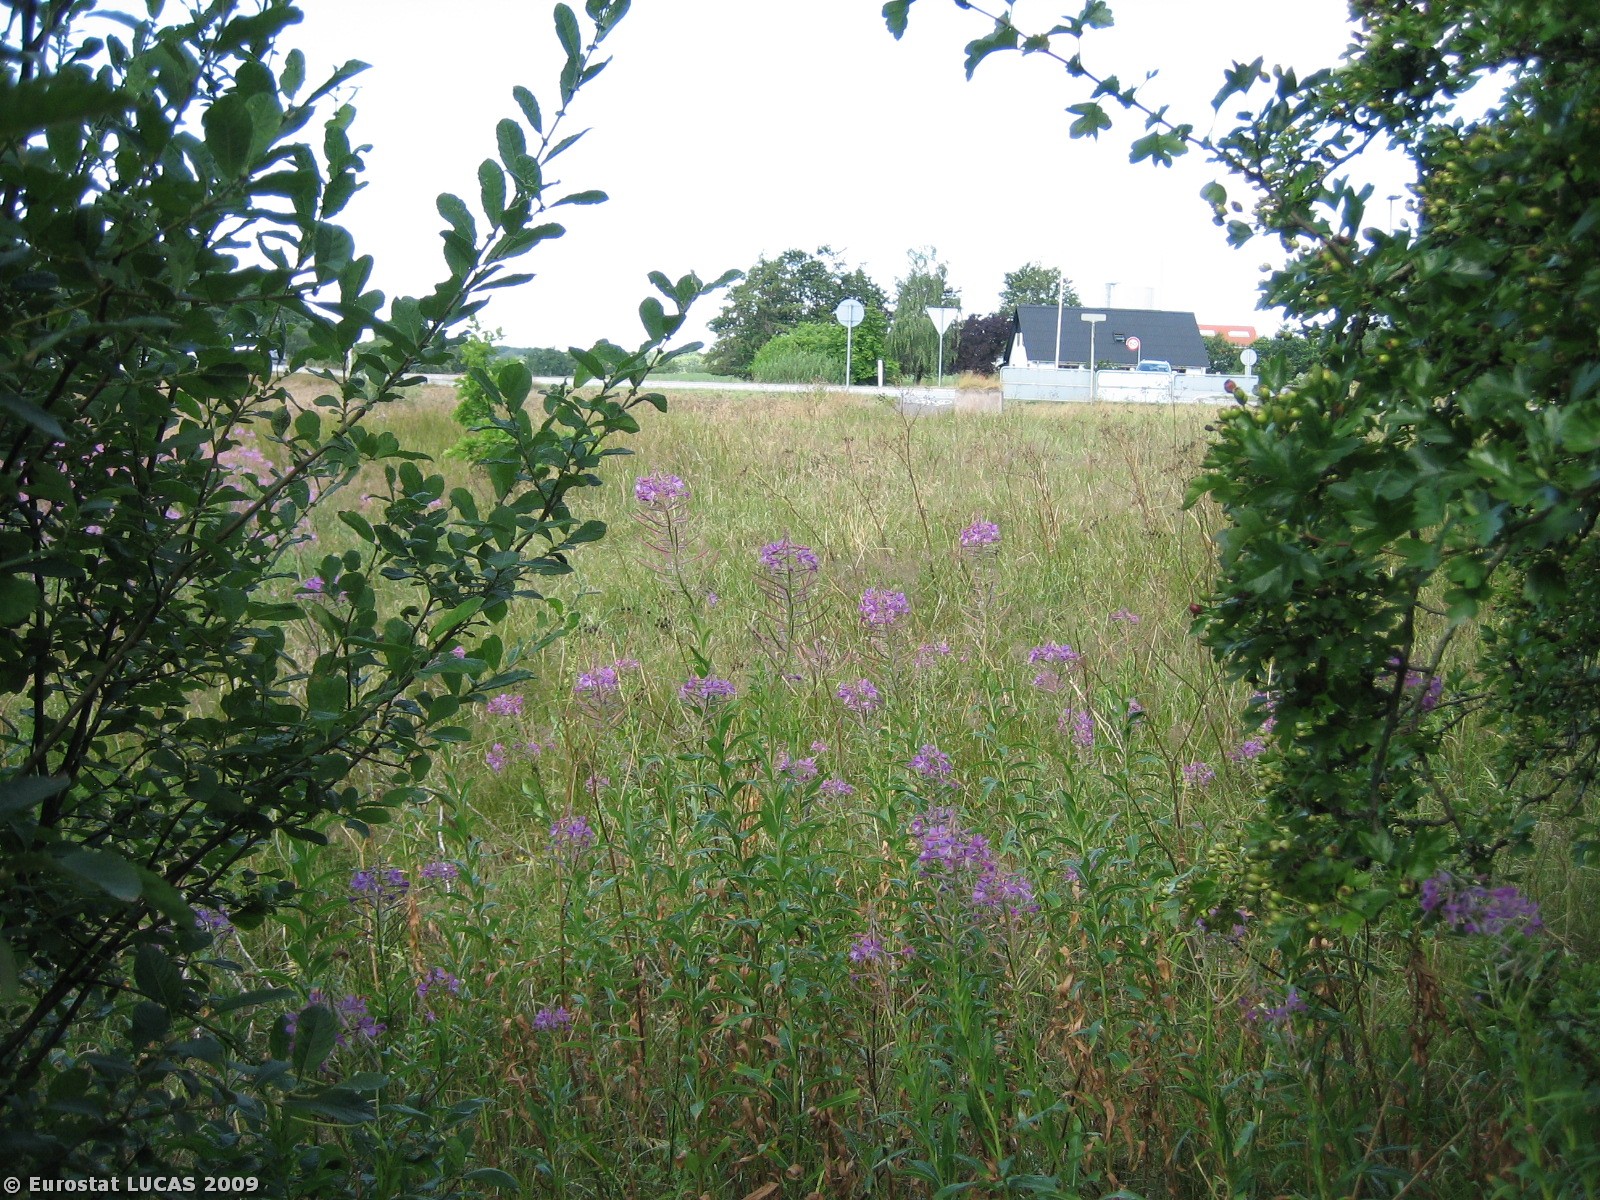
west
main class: Grassland
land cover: Grassland with sparse tree/shrub cover
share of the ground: > 75 %
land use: Residential
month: July
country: DK
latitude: 55.6971
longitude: 8.8397
